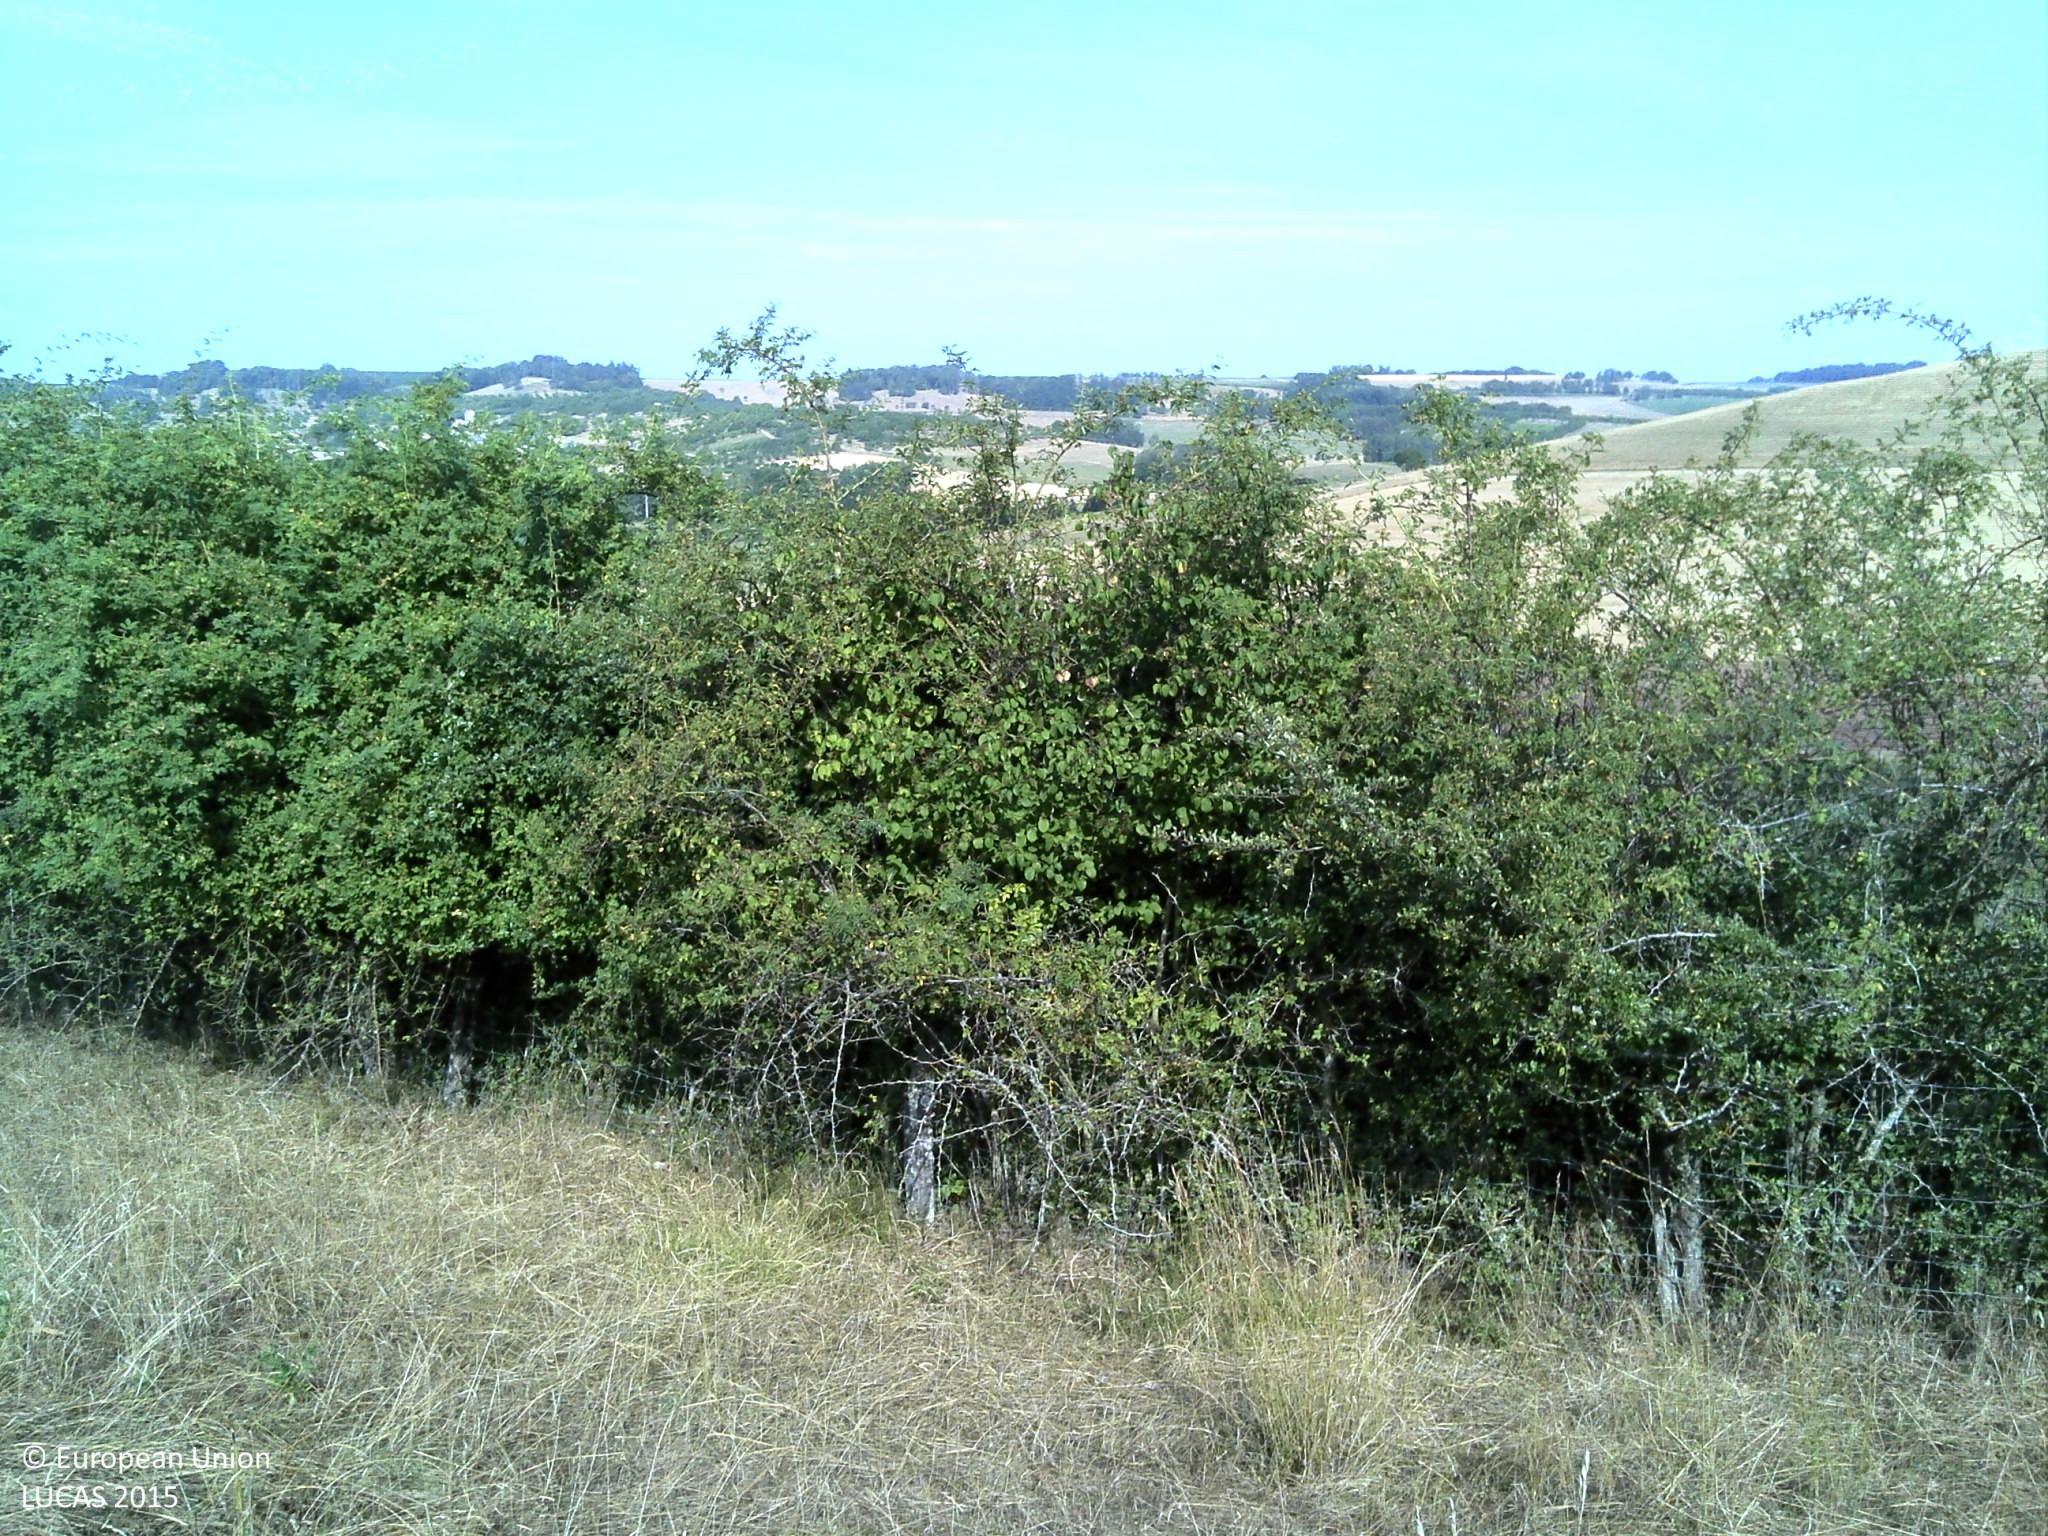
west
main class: Grassland
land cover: Grassland with sparse tree/shrub cover
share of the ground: > 75 %
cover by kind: herbaceous plants 95 %, broadleaved forest trees 5 %
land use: Agriculture (excluding fallow land and kitchen gardens)
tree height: < 5 m
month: July
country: FR
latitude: 48.3053
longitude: 6.2929
